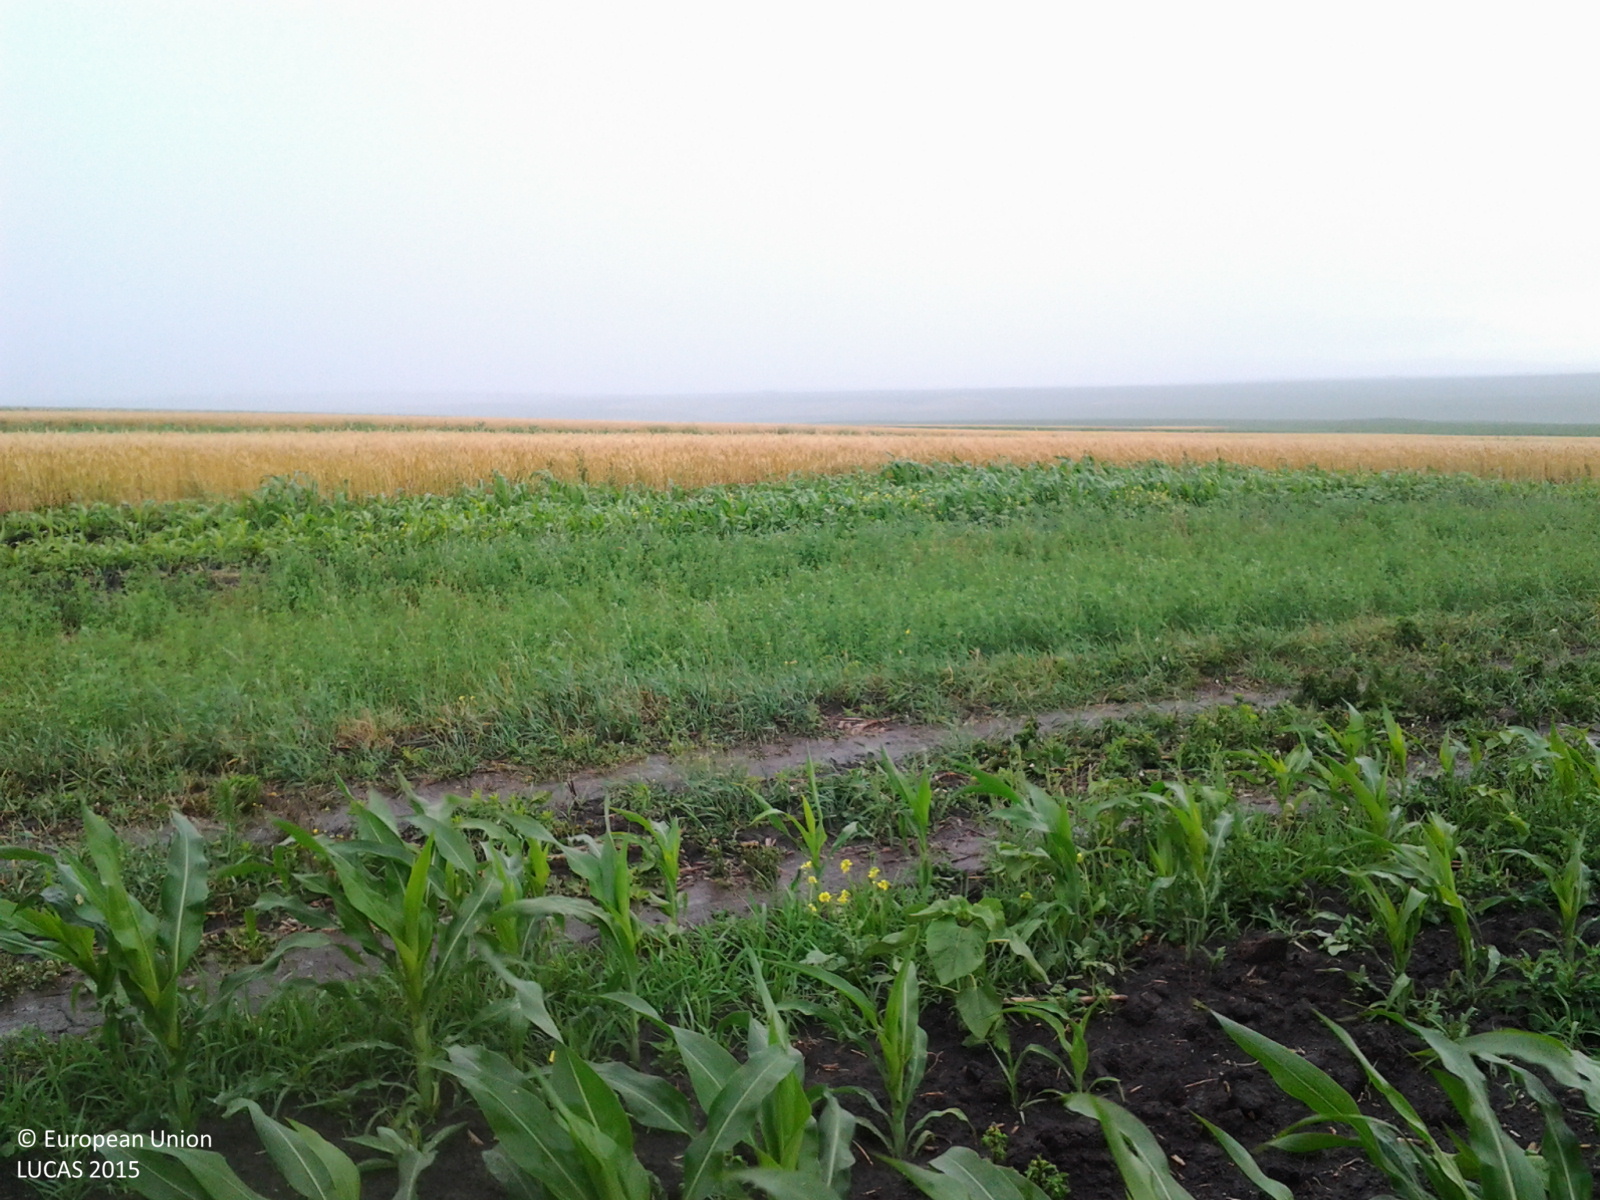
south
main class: Cropland
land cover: Maize
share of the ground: 10 - 25 %
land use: Agriculture (excluding fallow land and kitchen gardens)
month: June
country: RO
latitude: 47.9004
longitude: 26.5326
